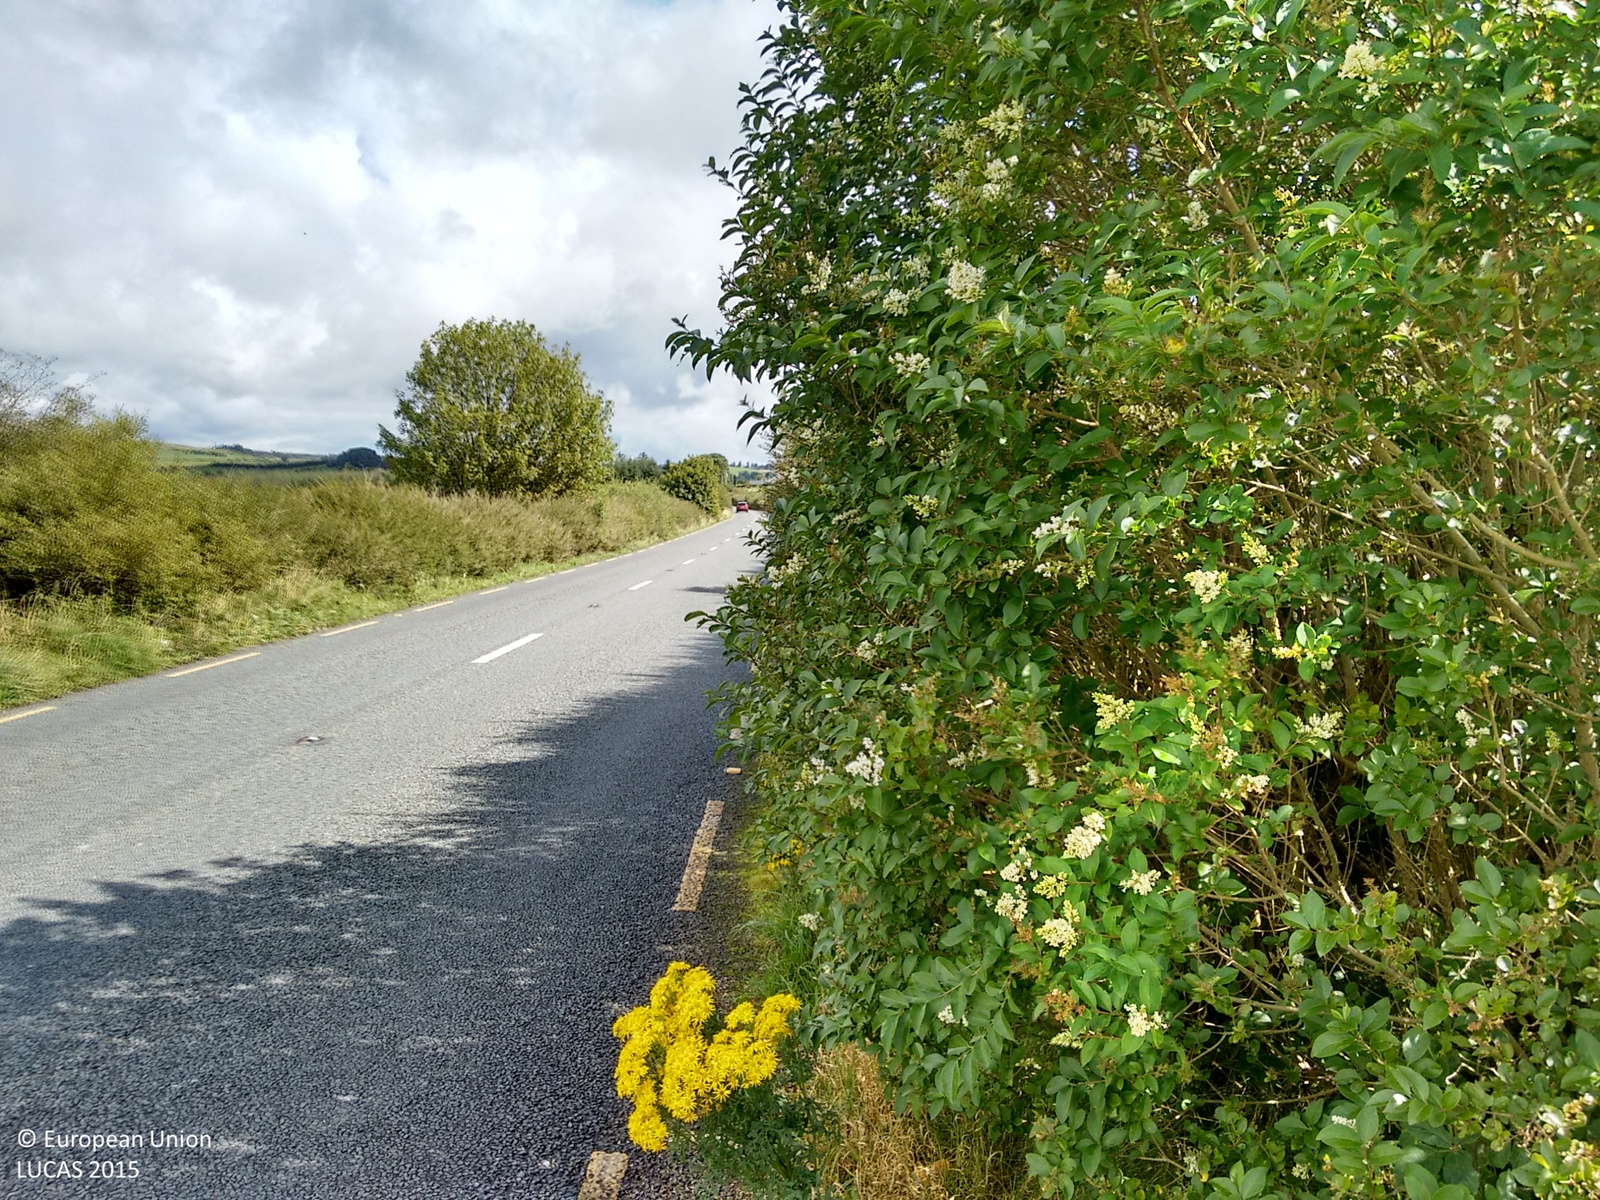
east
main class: Grassland
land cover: Grassland without tree/shrub cover
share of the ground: > 75 %
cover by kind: herbaceous plants 100 %
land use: Agriculture (excluding fallow land and kitchen gardens)
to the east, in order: Grassland without tree/shrub cover; Fences; Abandoned hedges; Lines of trees; Grassland without tree/shrub cover
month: August
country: IE
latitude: 52.1720
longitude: -9.3374
